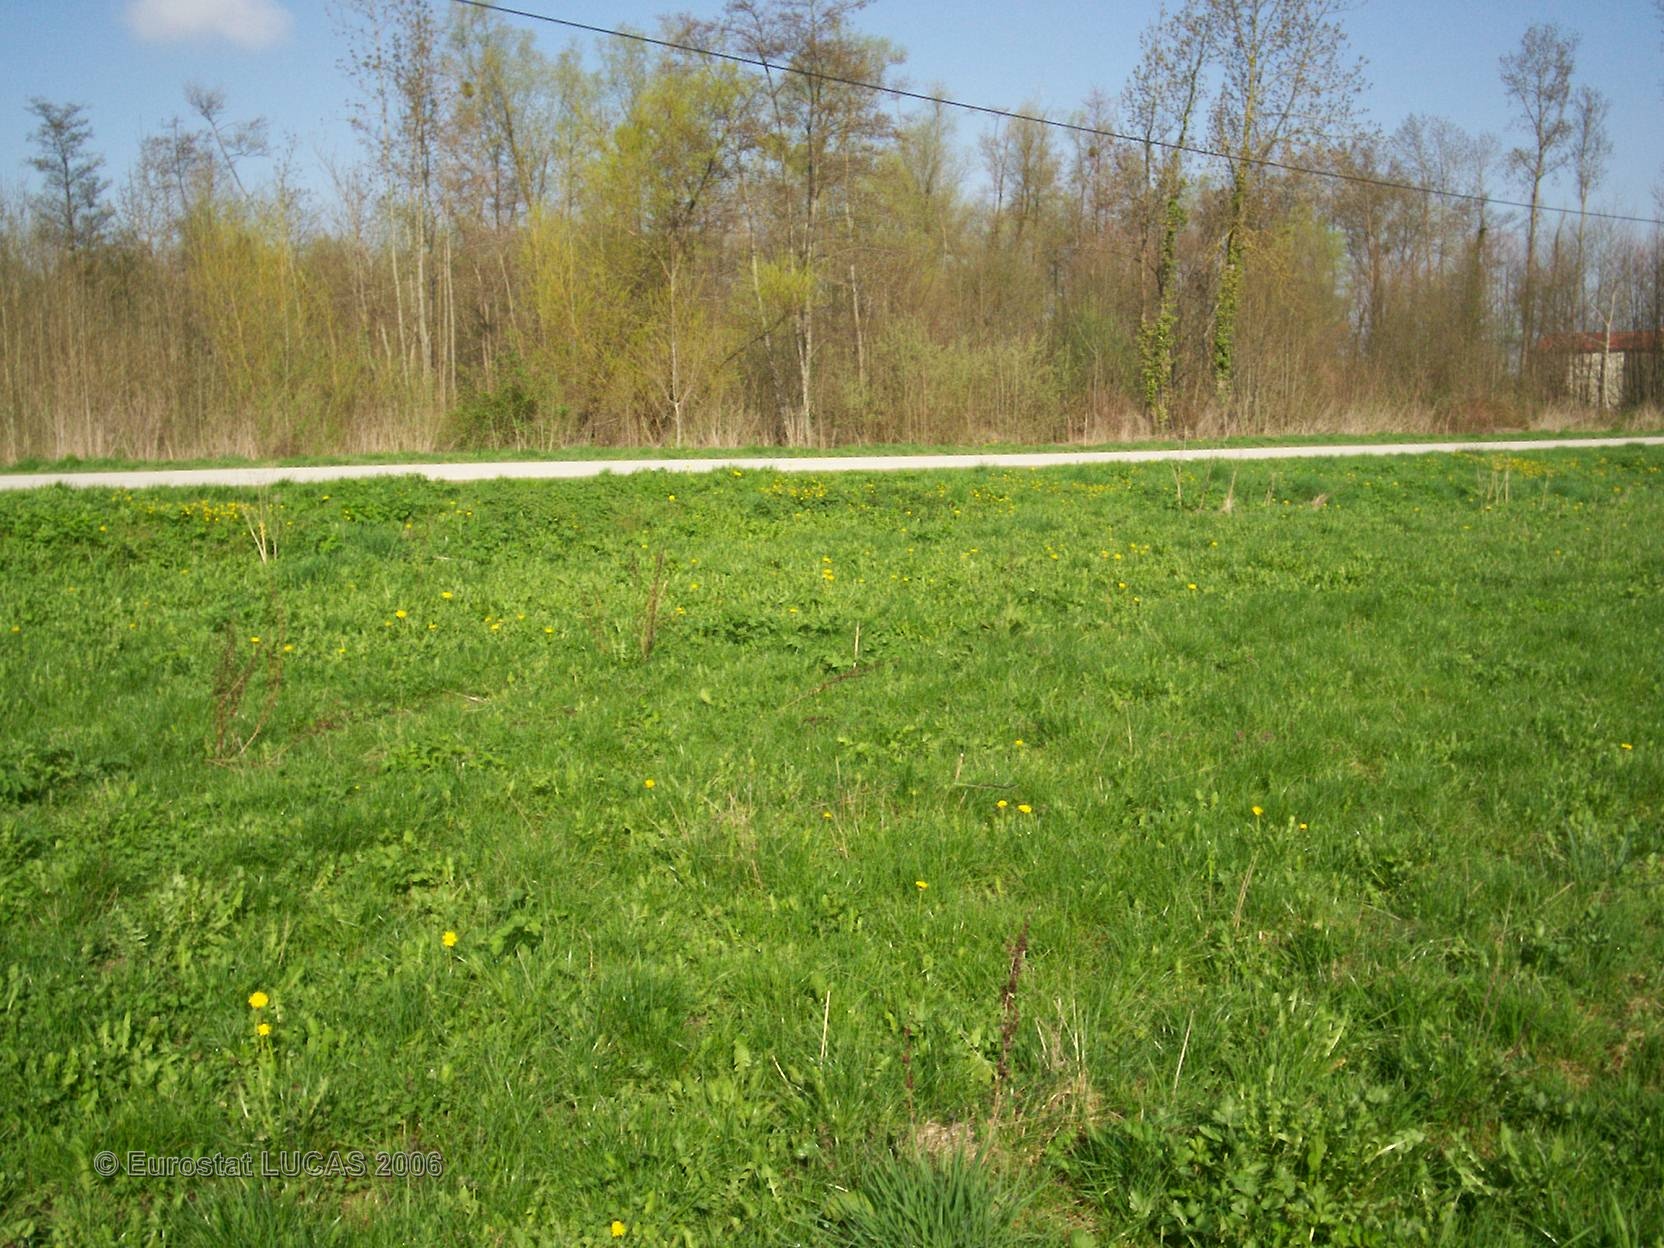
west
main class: Grassland
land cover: Grassland without tree/shrub cover
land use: Agriculture (excluding fallow land and kitchen gardens)
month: April
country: FR
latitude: 48.5171
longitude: 4.4600
